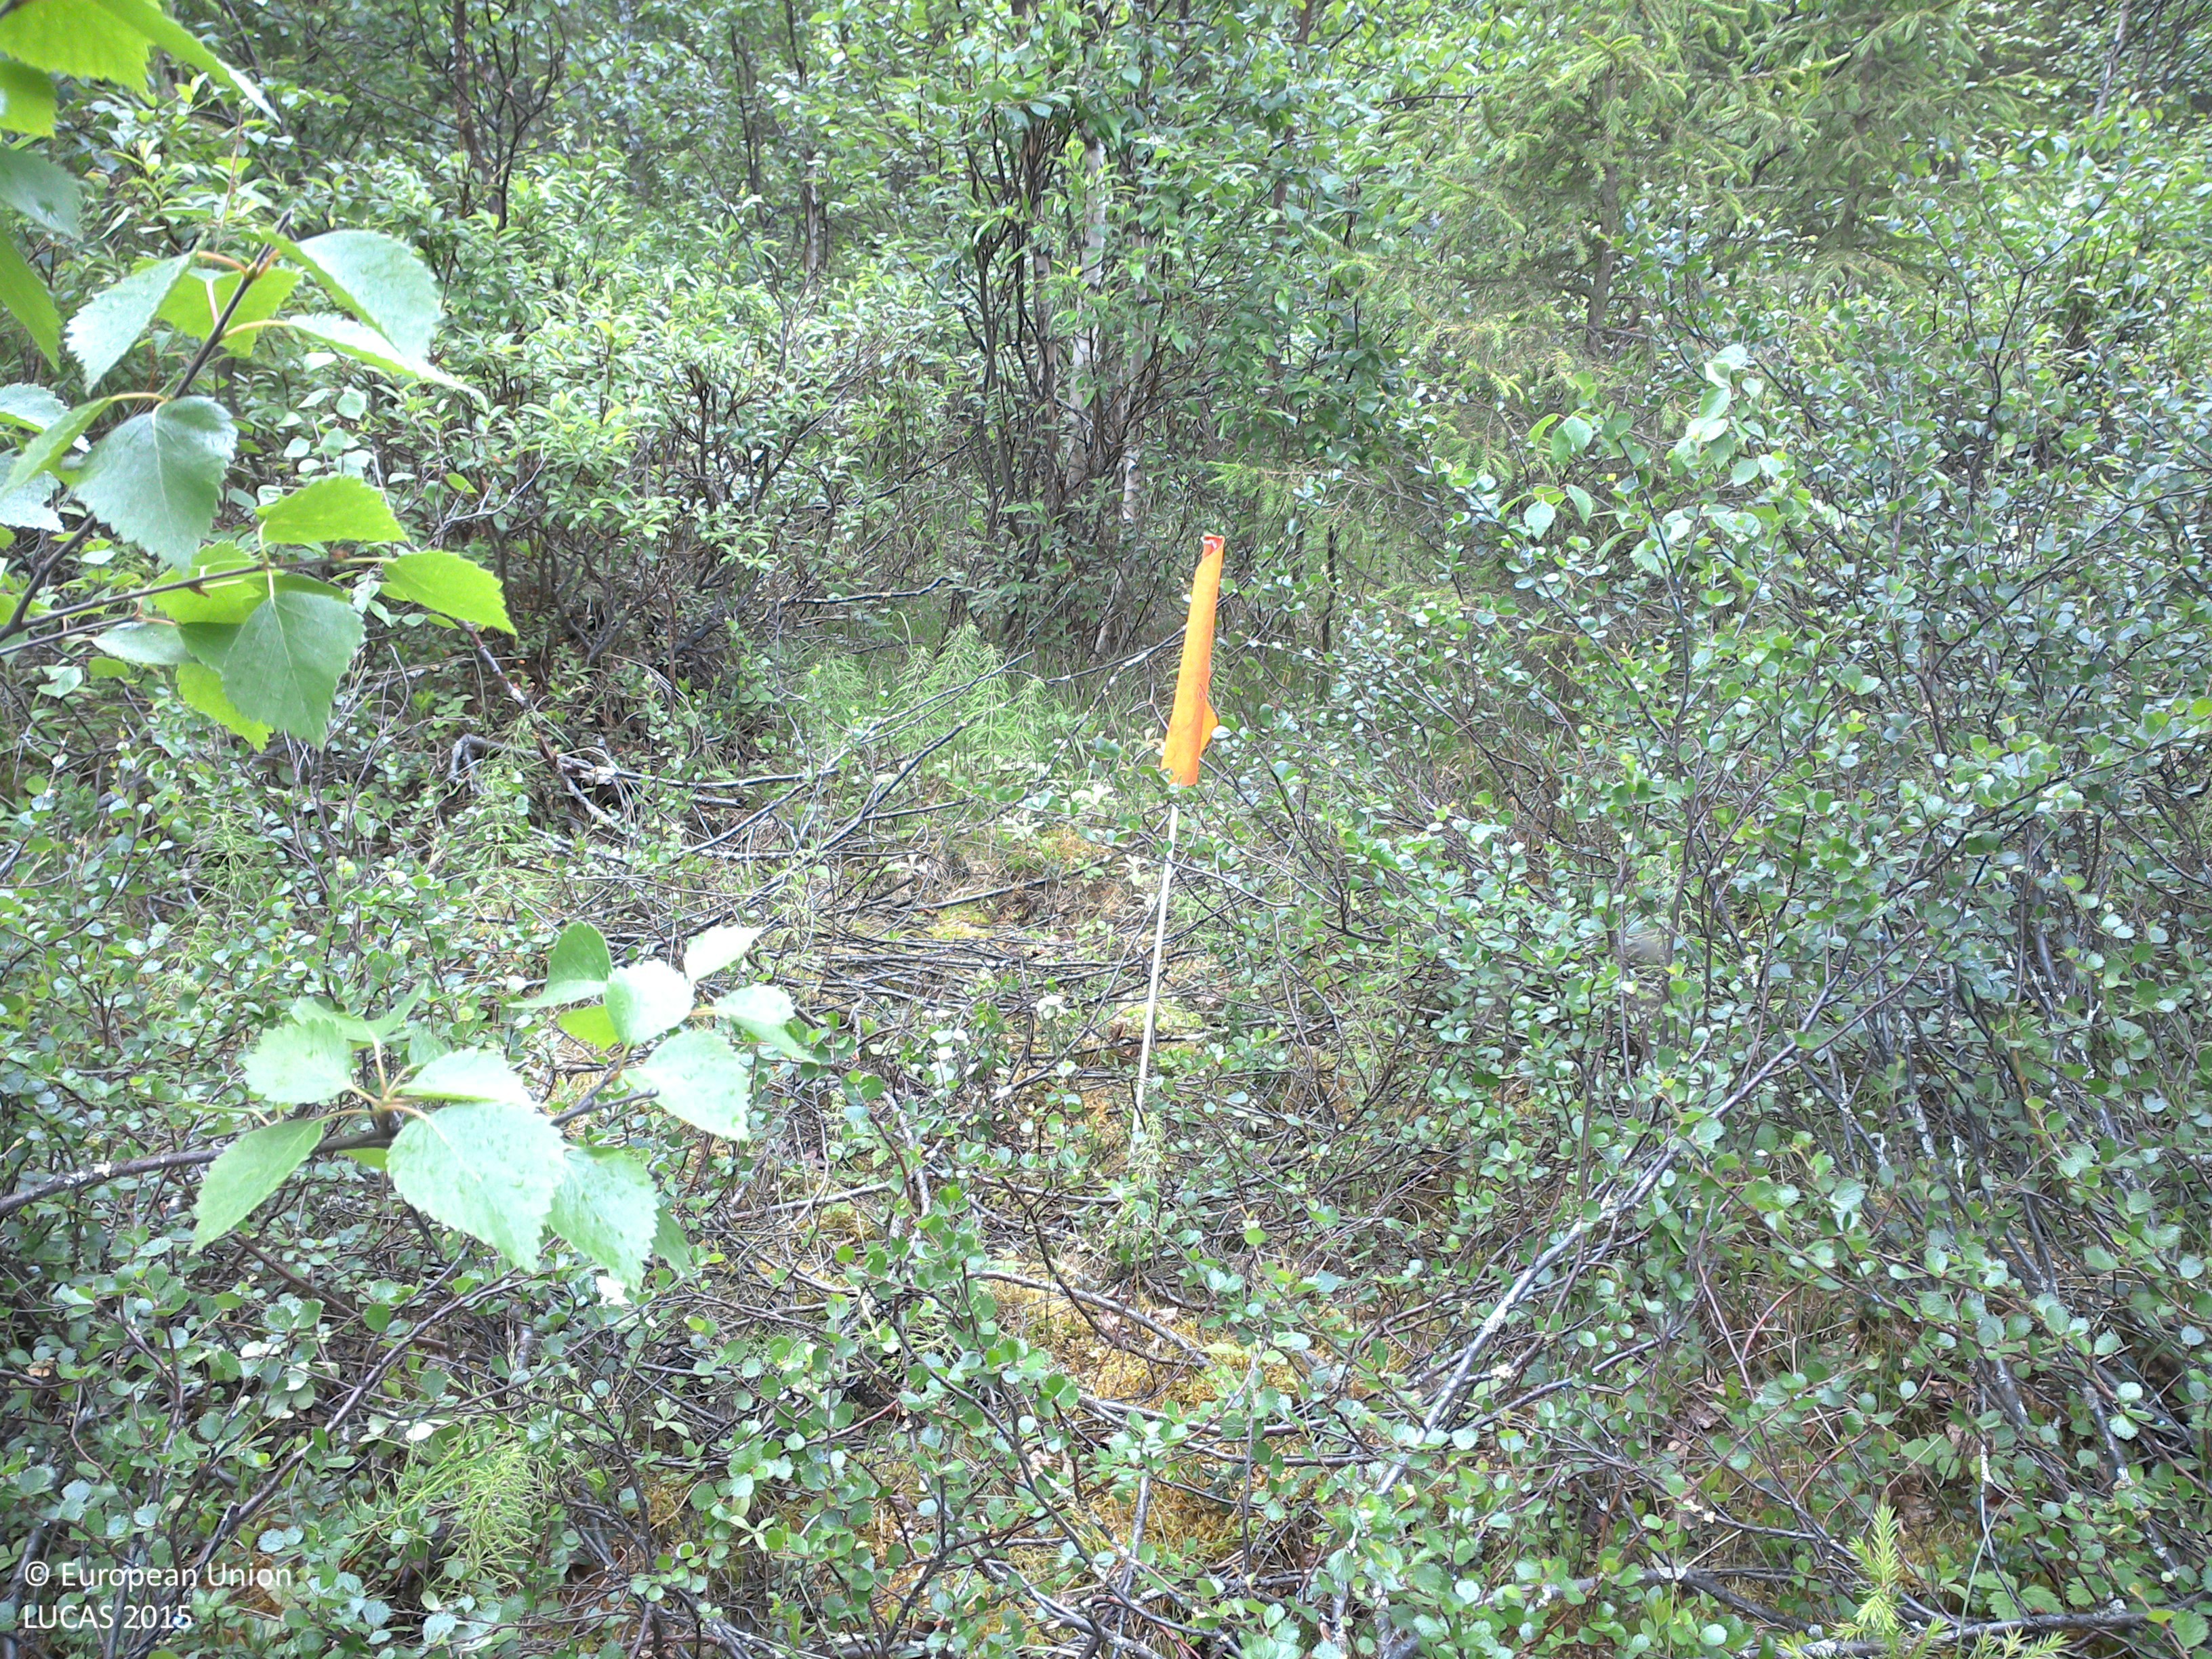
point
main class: Woodland
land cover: Other mixed woodland
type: boreal forest
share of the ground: 25 - 50 %
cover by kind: shrubs 65 %, broadleaved forest trees 20 %, coniferous forest trees 10 %, lichens and mosses 5 %
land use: Forestry
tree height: > 5 m
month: July
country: SE
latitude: 66.8234
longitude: 23.8972
